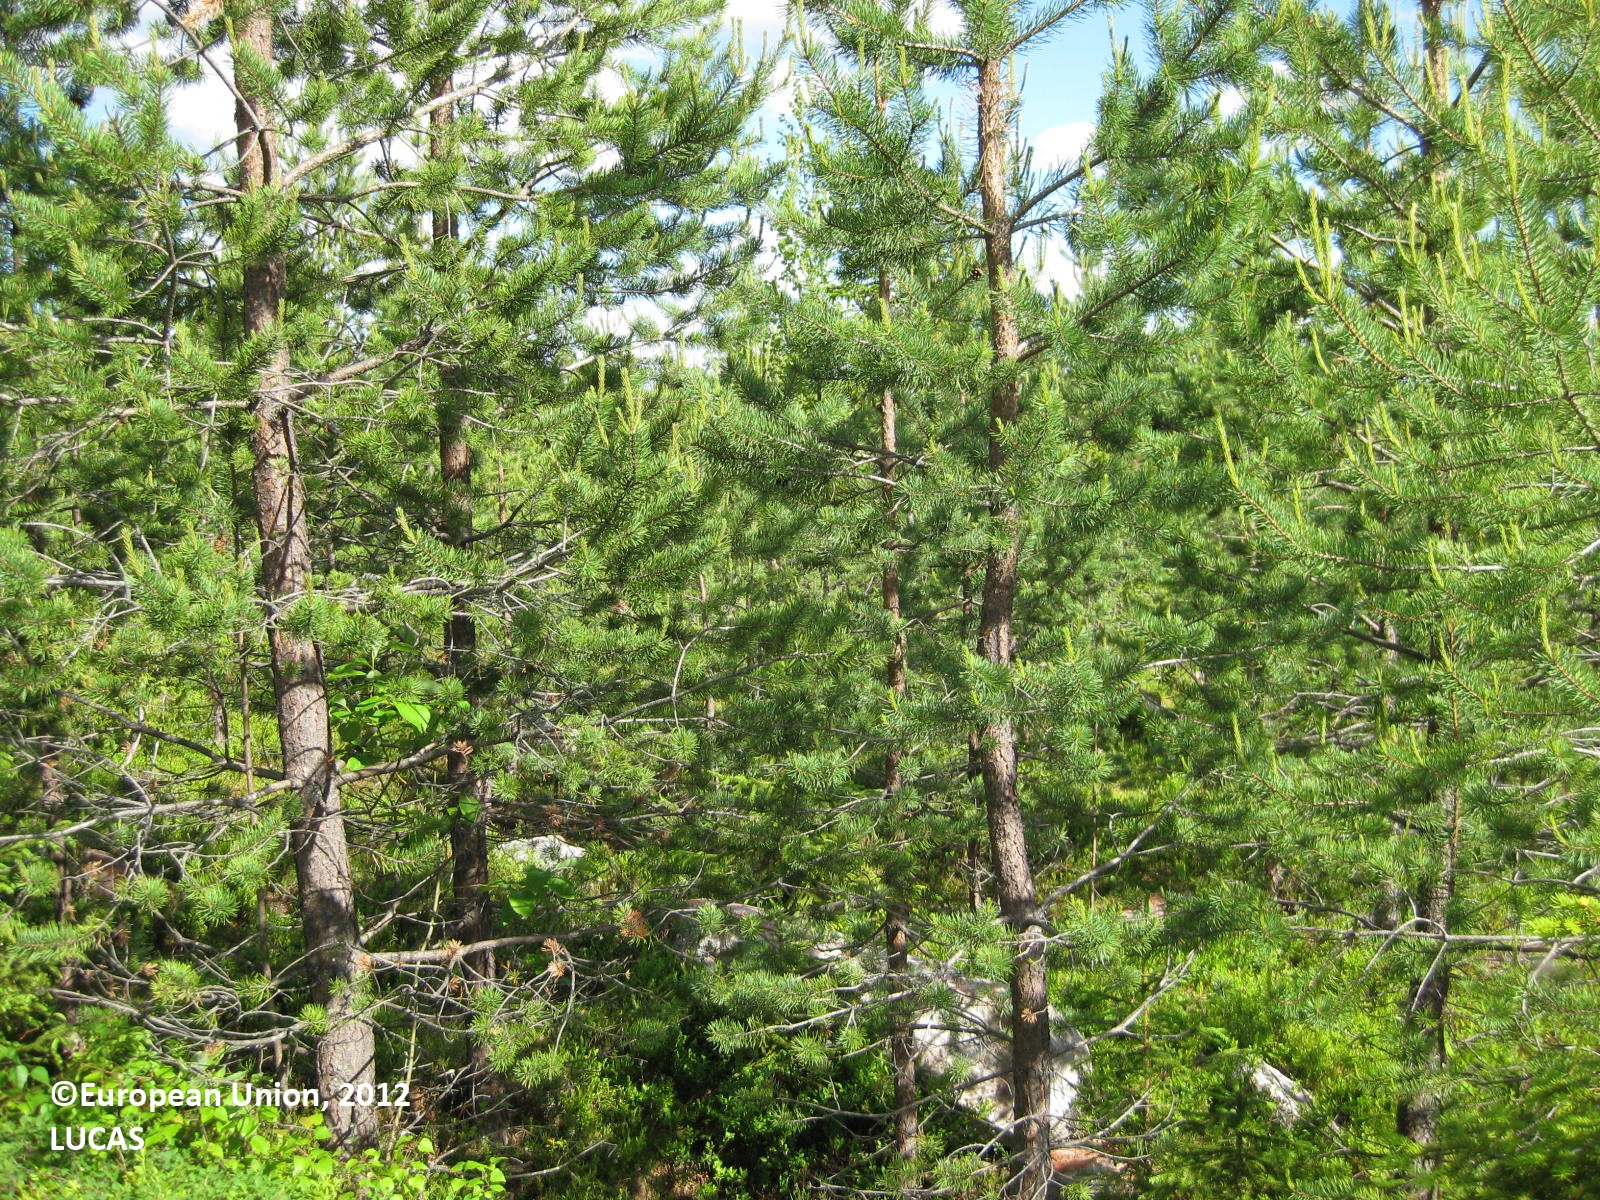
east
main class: Woodland
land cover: Pine dominated coniferous woodland
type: boreal forest
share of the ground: > 75 %
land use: Forestry
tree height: > 5 m
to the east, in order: Pine dominated coniferous woodland; Ditches and canals; Pine dominated coniferous woodland; Ditches and canals; Pine dominated coniferous woodland; Ditches and canals; Pine dominated coniferous woodland; Ditches and canals; Pine dominated coniferous woodland; Spruce dominated mixed woodland; Other coniferous woodland; Pine dominated coniferous woodland; Spruce dominated mixed woodland; Ditches and canals; Other bare soil
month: July
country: FI
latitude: 65.5962
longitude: 29.4343
